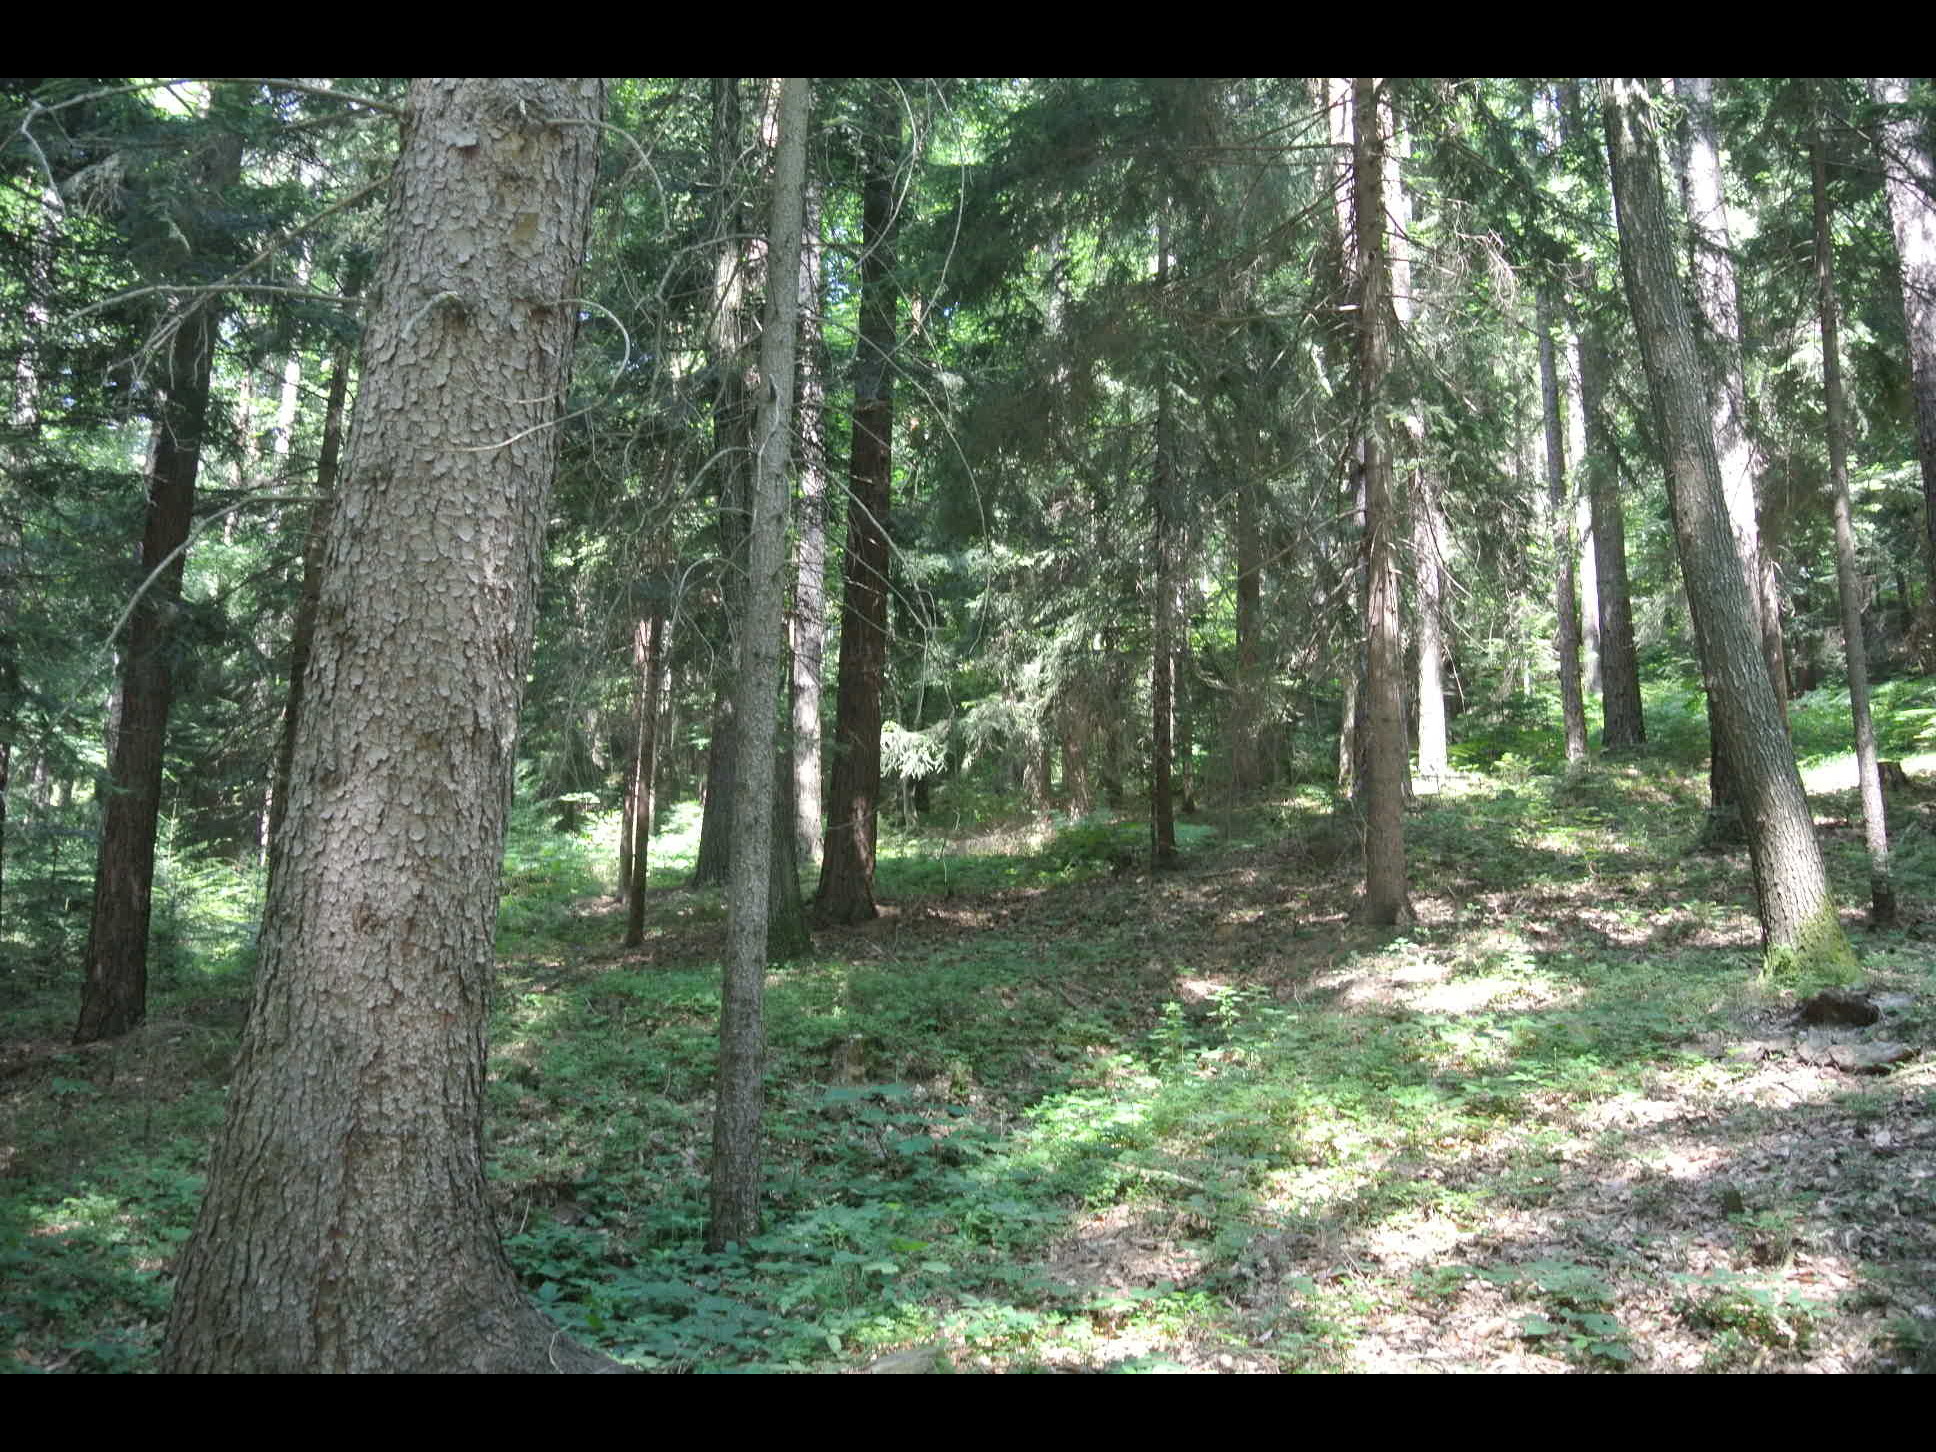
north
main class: Woodland
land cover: Other mixed woodland
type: alpine coniferous forest
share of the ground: > 75 %
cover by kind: coniferous forest trees 60 %, broadleaved forest trees 35 %, herbaceous plants 5 %
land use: Forestry
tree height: > 5 m
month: July
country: AT
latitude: 47.6344
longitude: 16.1918
